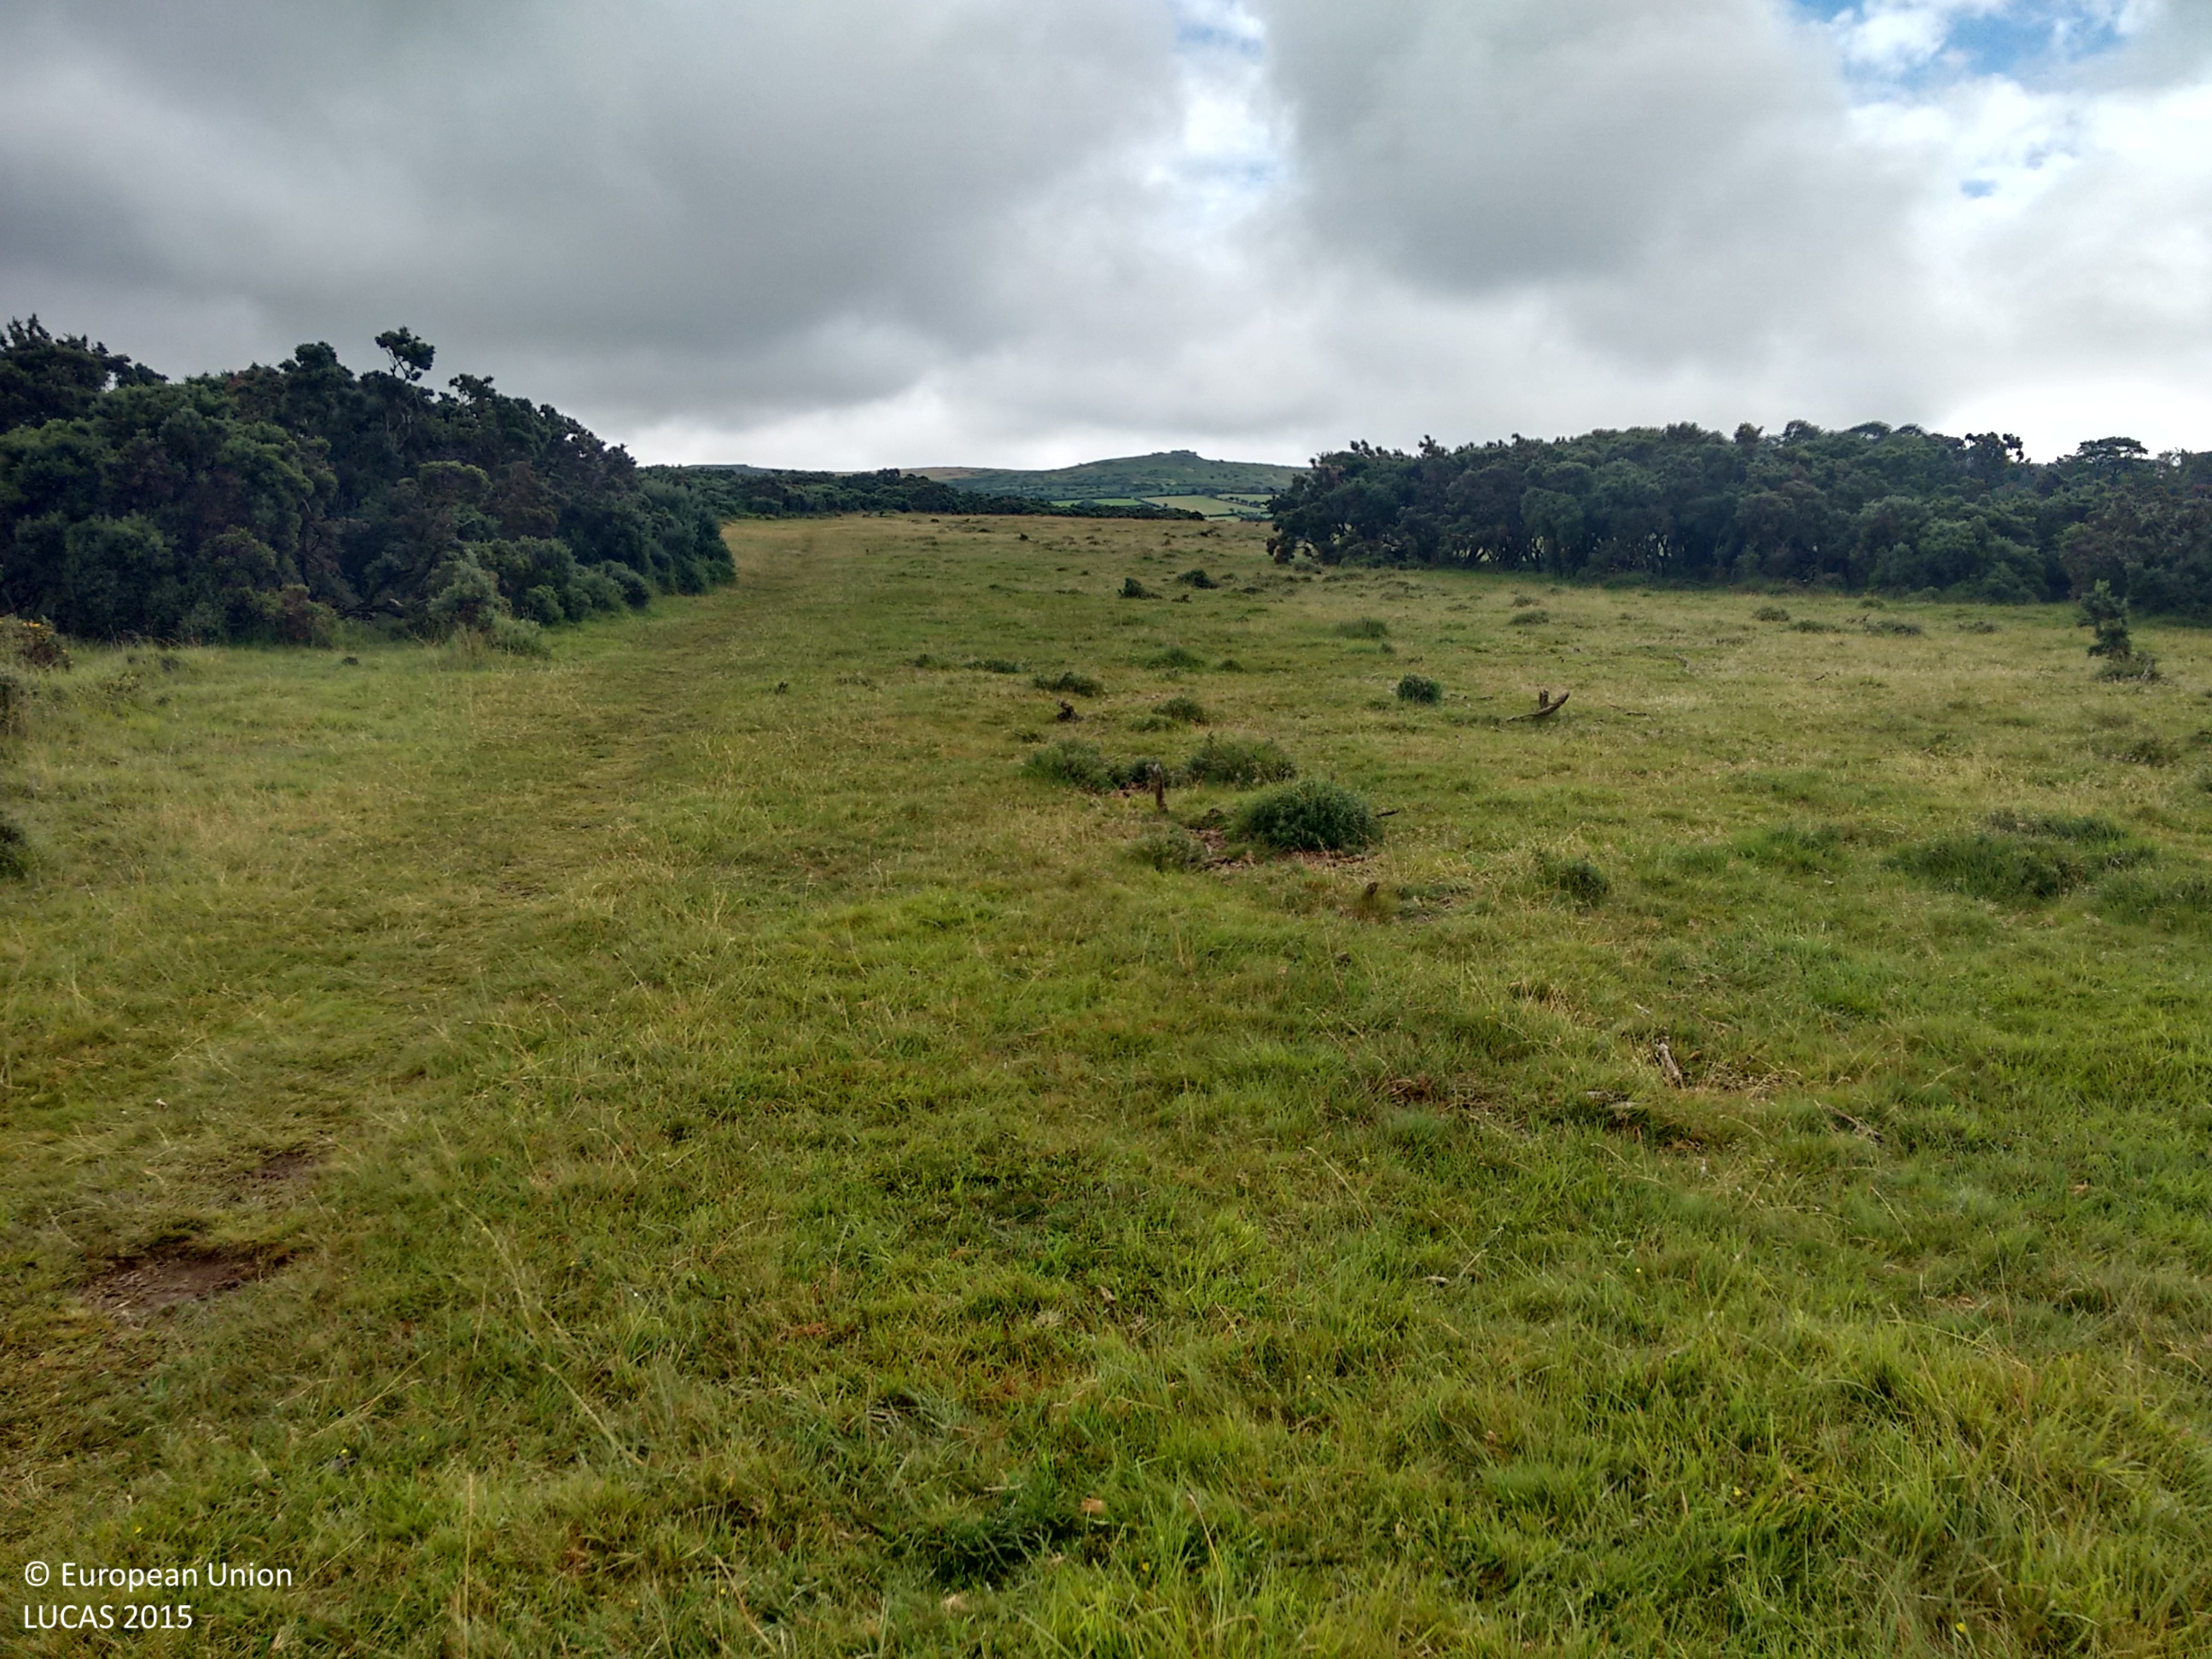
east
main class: Shrubland
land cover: Shrubland without tree cover
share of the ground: > 75 %
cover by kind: herbaceous plants 75 %, shrubs 25 %
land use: Agriculture (excluding fallow land and kitchen gardens)
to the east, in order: Shrubland without tree cover; Grassland without tree/shrub cover
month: August
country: GB
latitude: 50.5429
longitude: -4.1084
